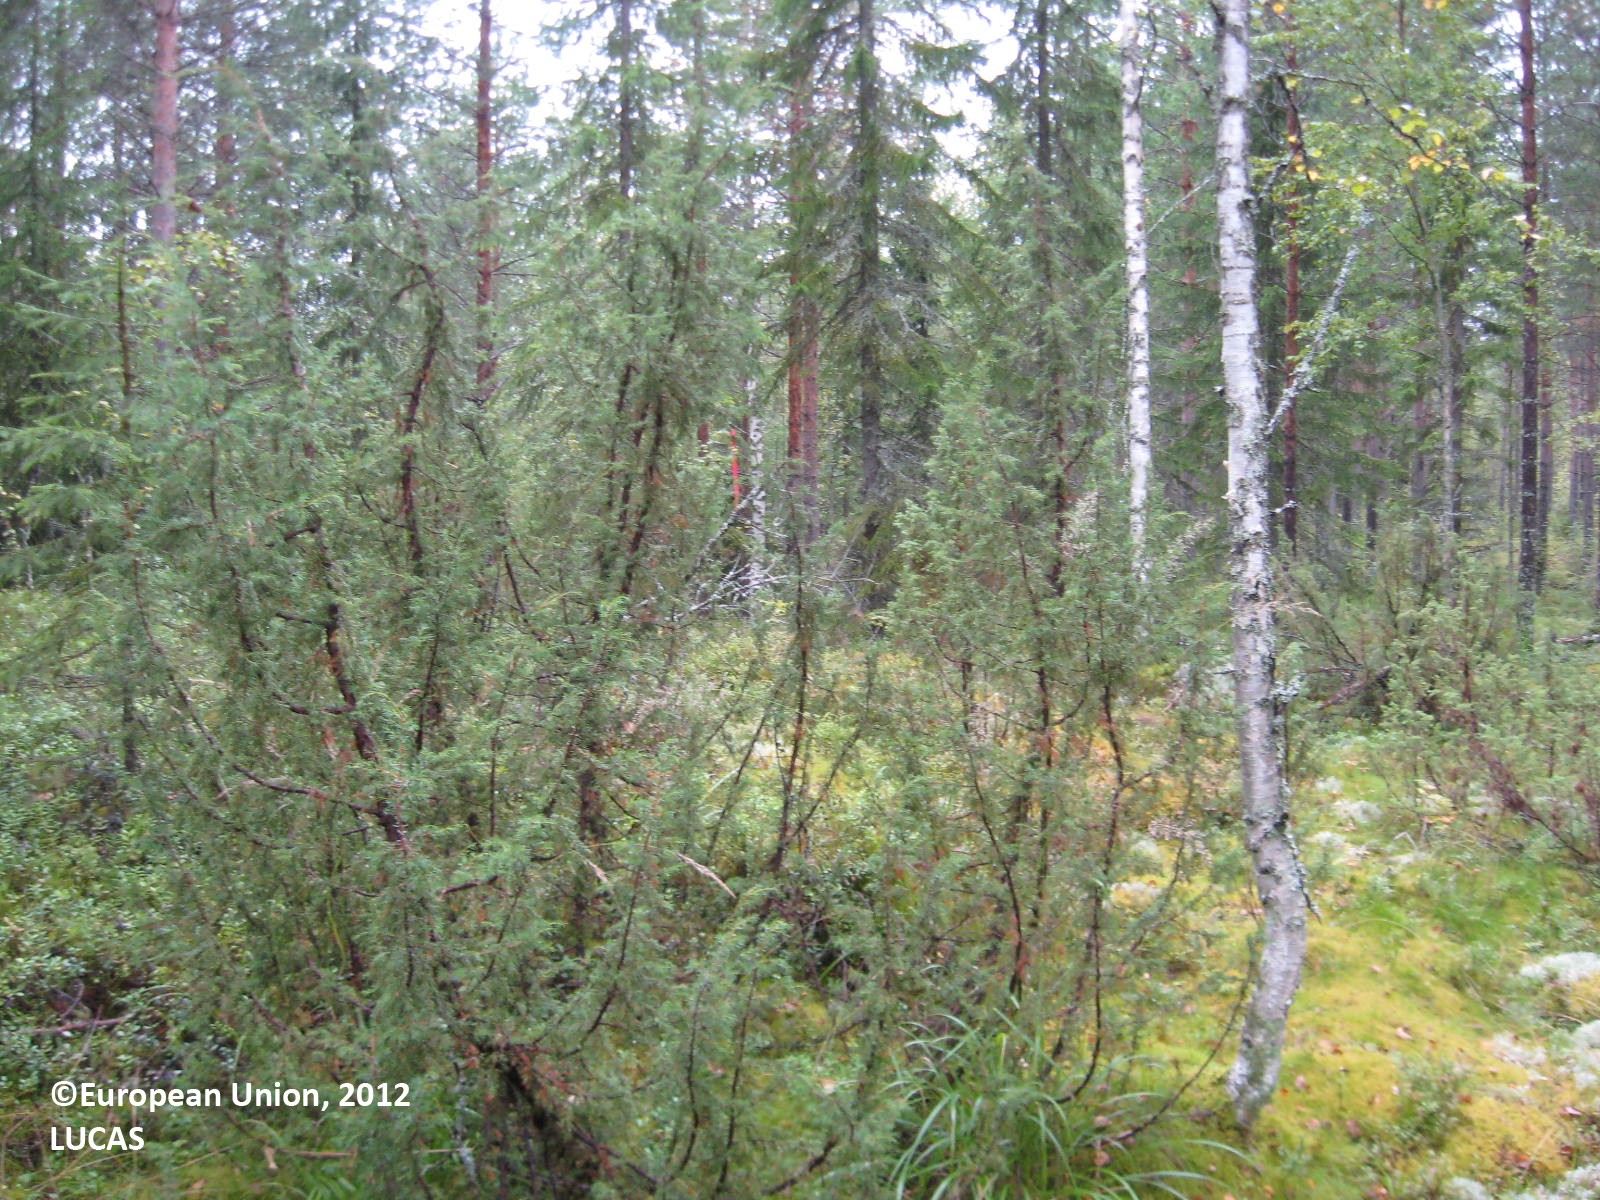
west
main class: Woodland
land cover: Pine dominated coniferous woodland
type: boreal forest
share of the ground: > 75 %
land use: Forestry
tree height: > 5 m
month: August
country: FI
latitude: 63.5104
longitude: 29.4564
